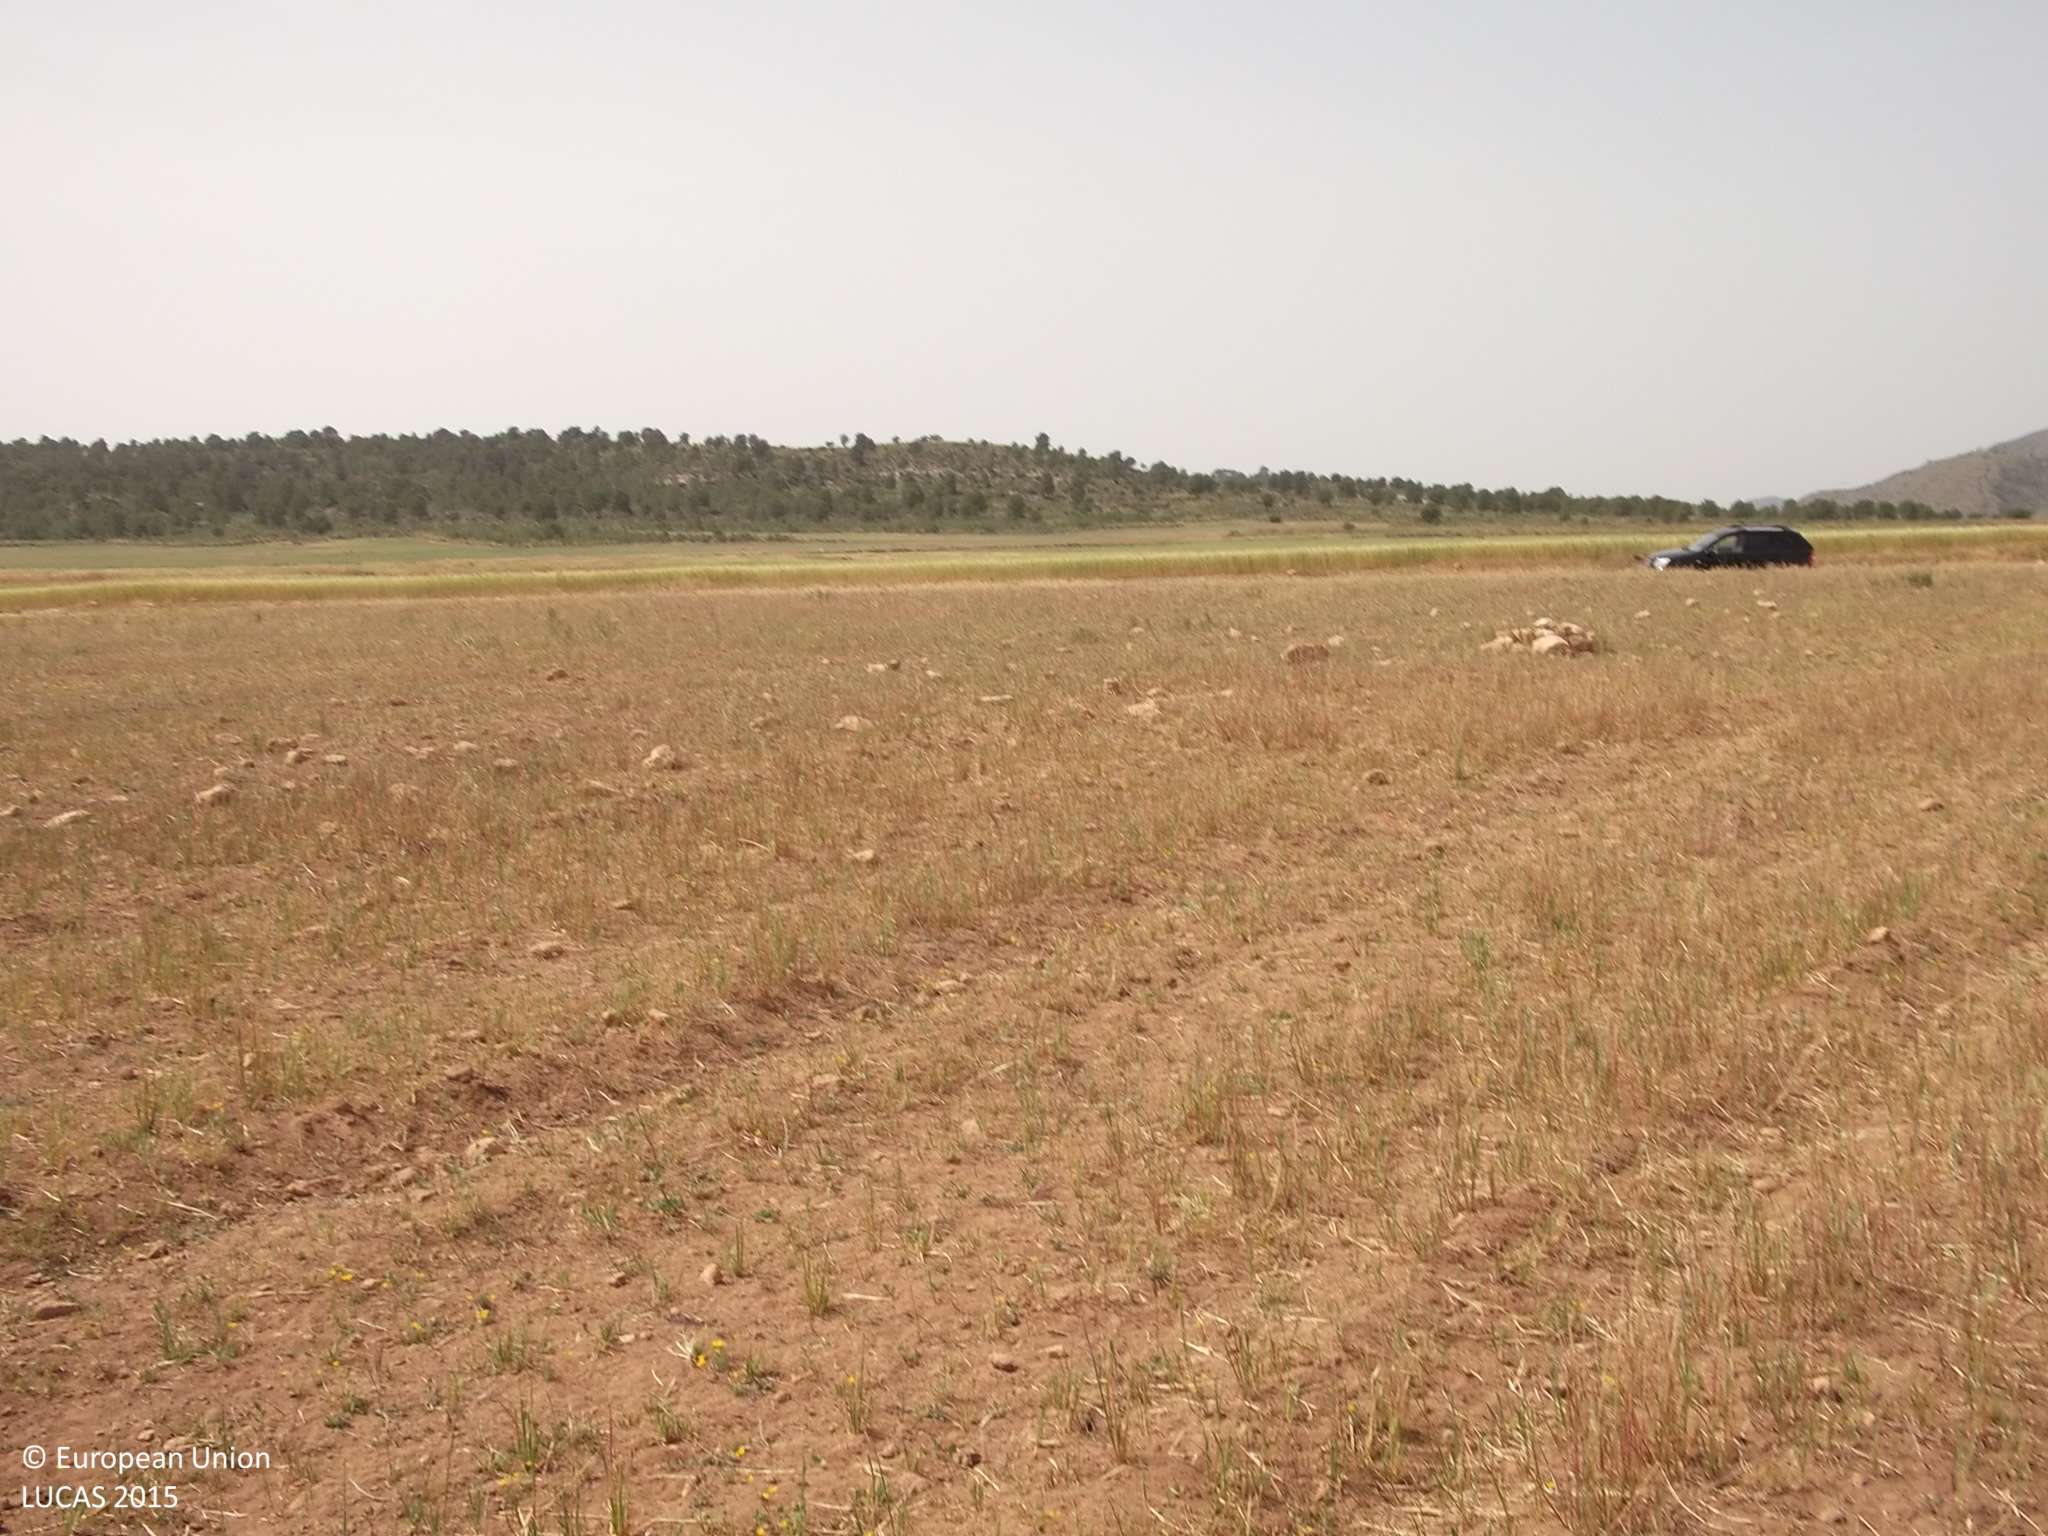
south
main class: Grassland
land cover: Spontaneously vegetated surfaces
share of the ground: 50 - 75 %
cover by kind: herbaceous plants 50 %, unconsolidated bare surface 50 %
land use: Fallow land
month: May
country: ES
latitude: 38.4564
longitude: -1.6466
